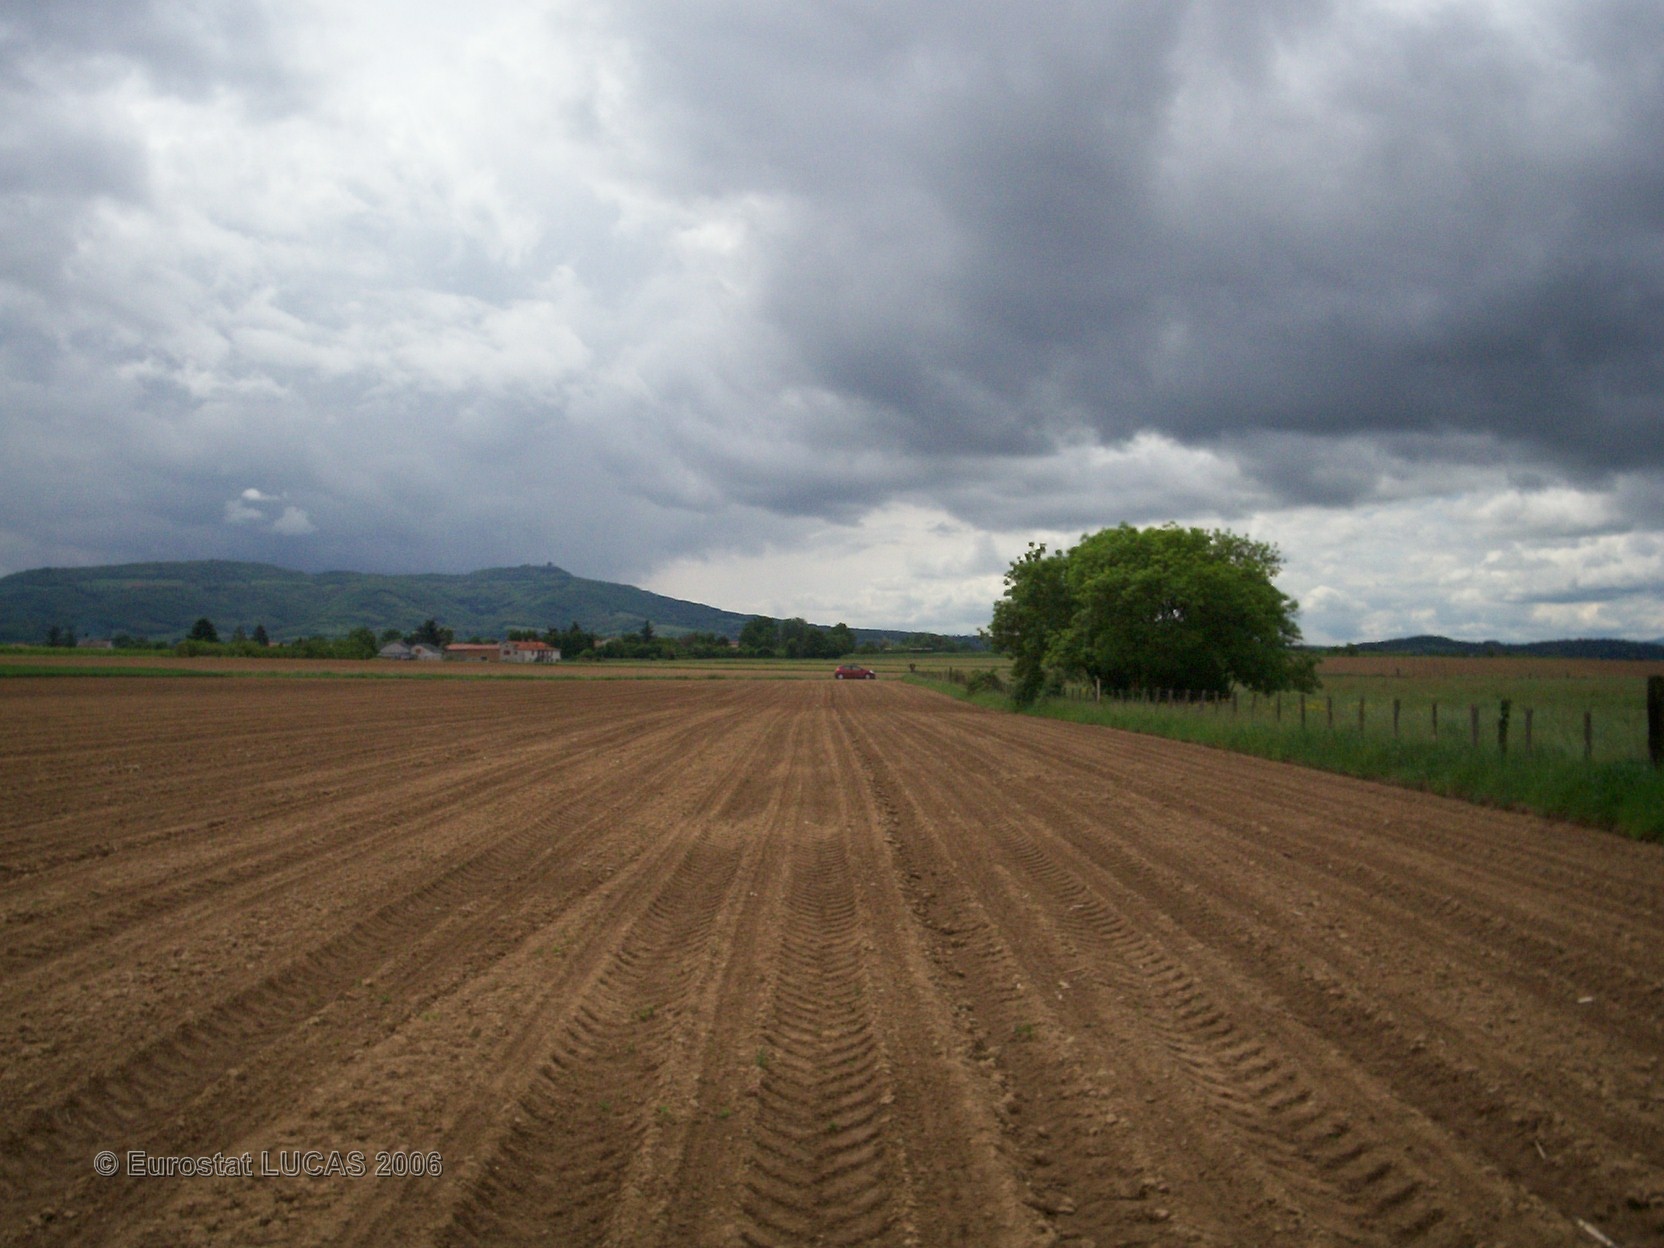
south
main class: Cropland
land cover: Maize
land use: Agriculture (excluding fallow land and kitchen gardens)
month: May
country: FR
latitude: 45.9157
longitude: 4.7557
